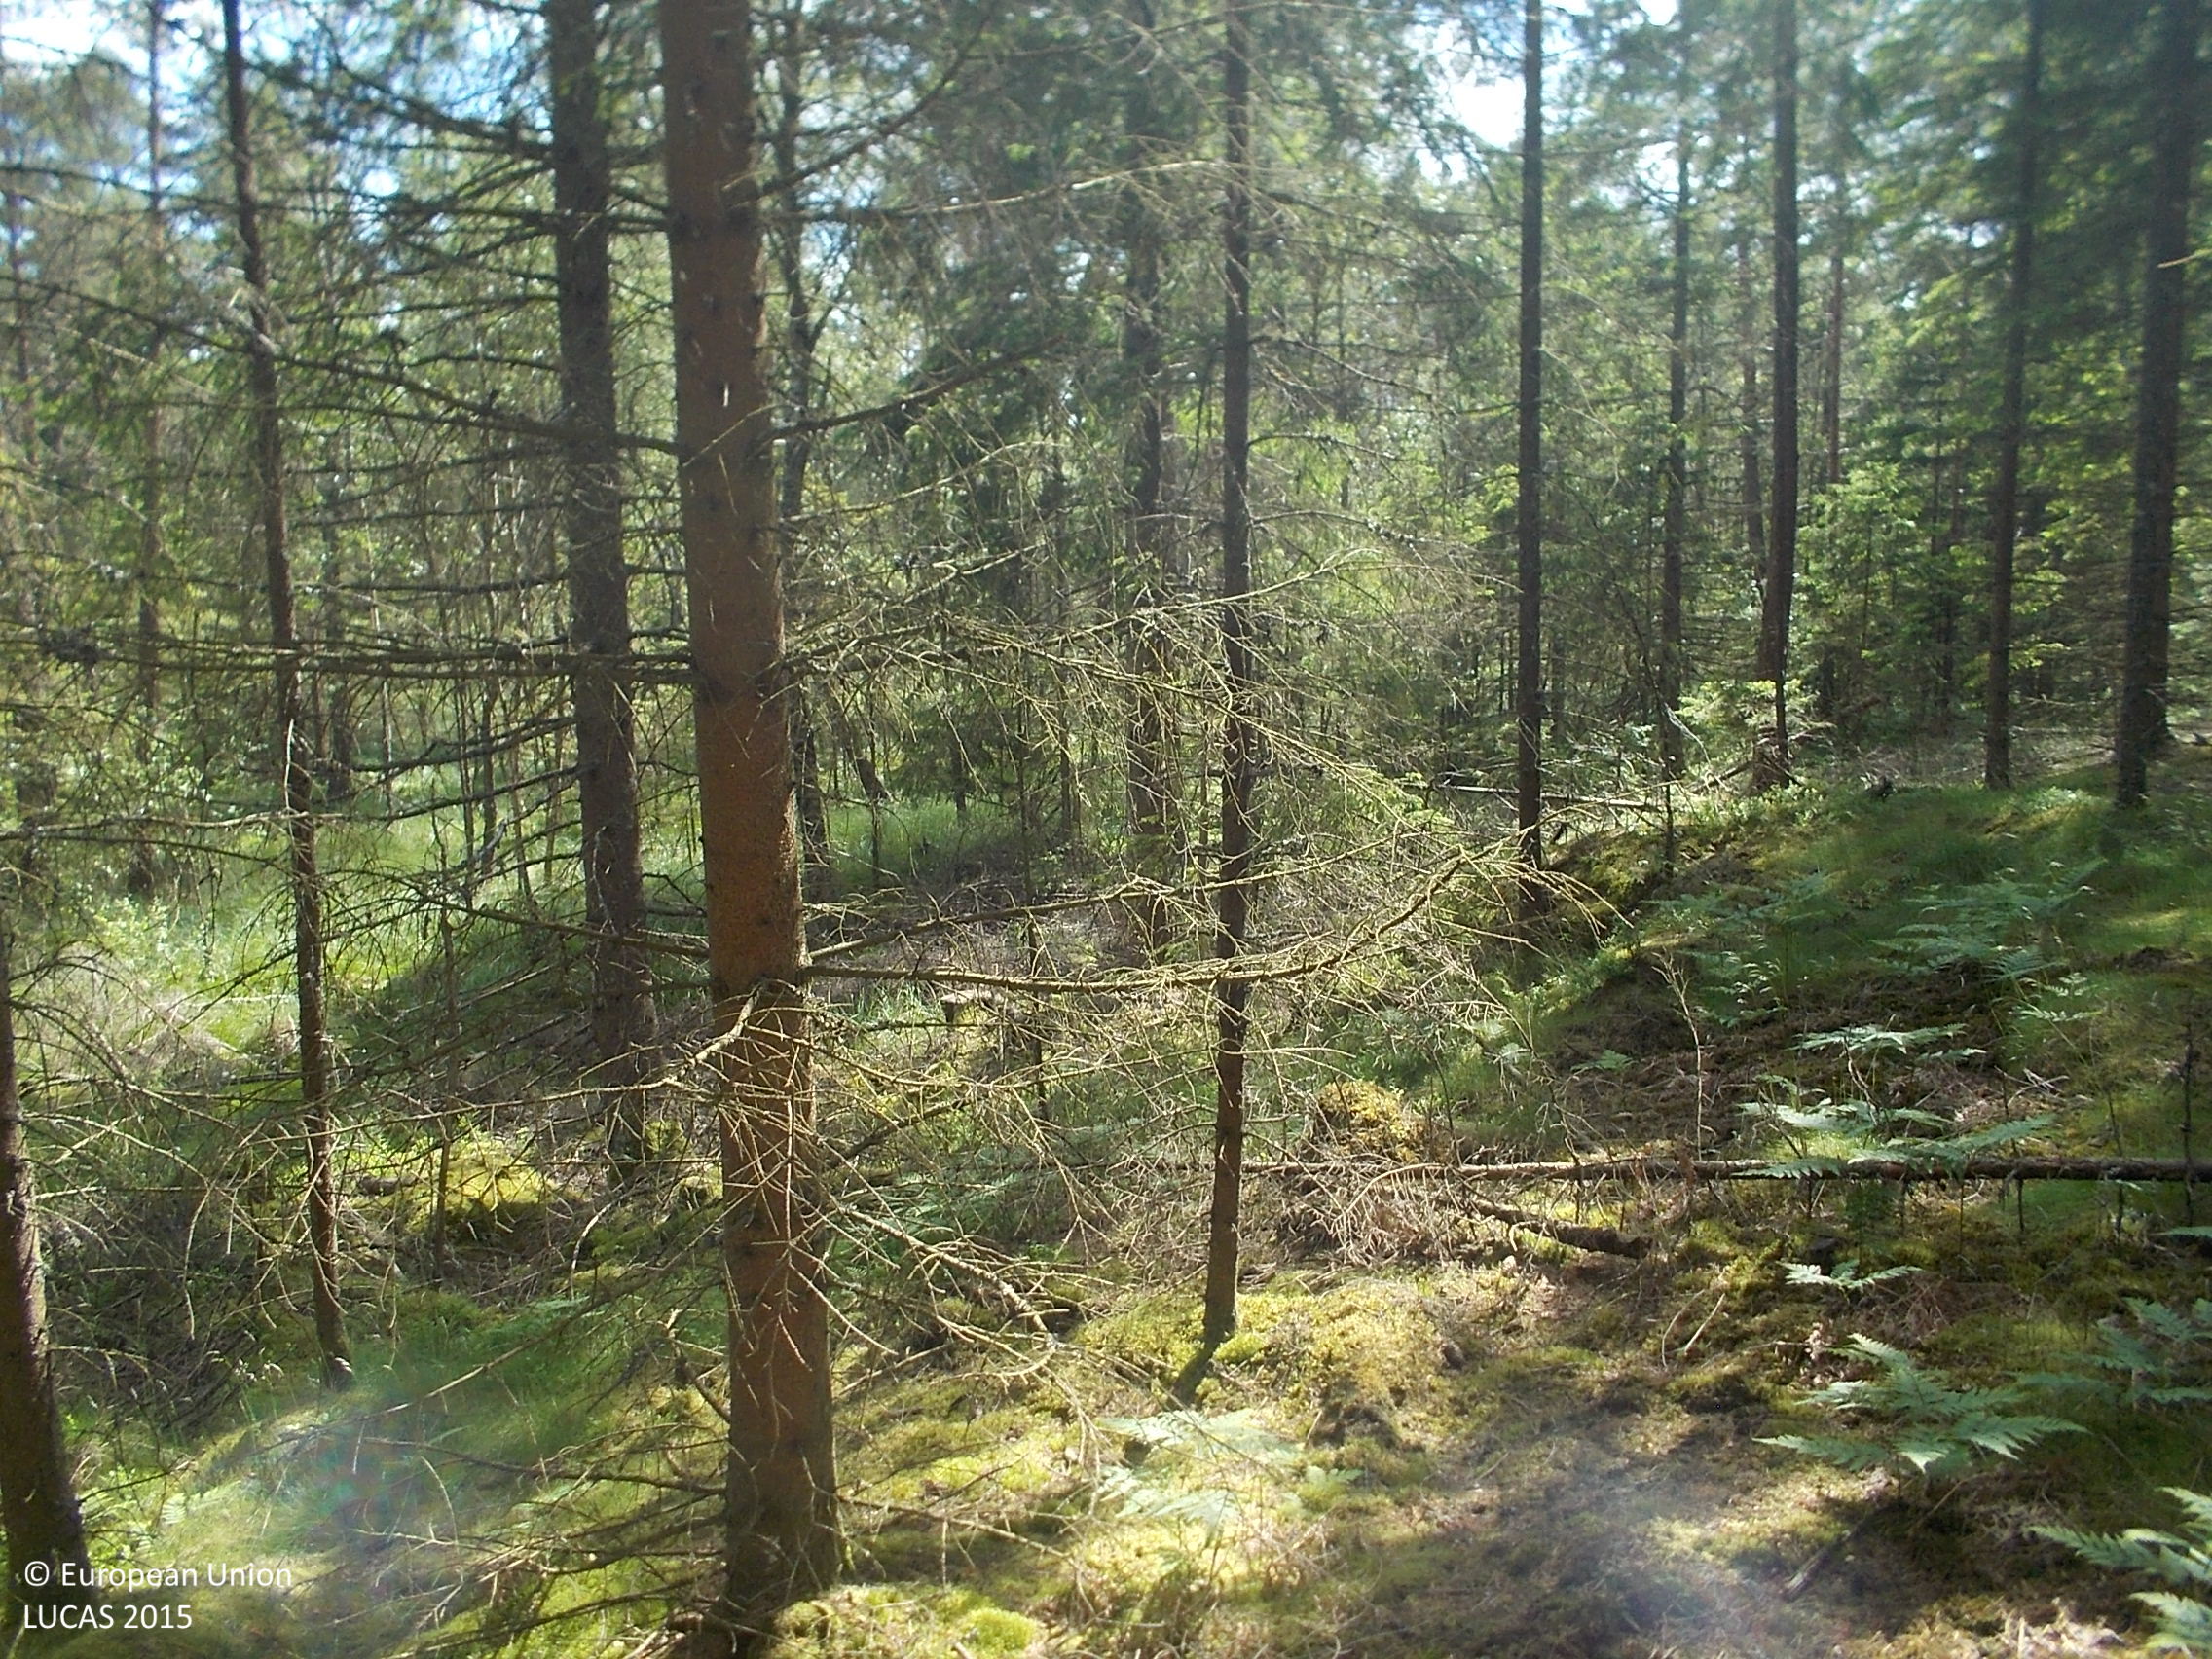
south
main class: Woodland
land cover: Spruce dominated coniferous woodland
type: boreal forest
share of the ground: > 75 %
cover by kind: coniferous forest trees 90 %, herbaceous plants 5 %, lichens and mosses 5 %
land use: Forestry
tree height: > 5 m
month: June
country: SE
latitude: 57.3206
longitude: 13.0681
